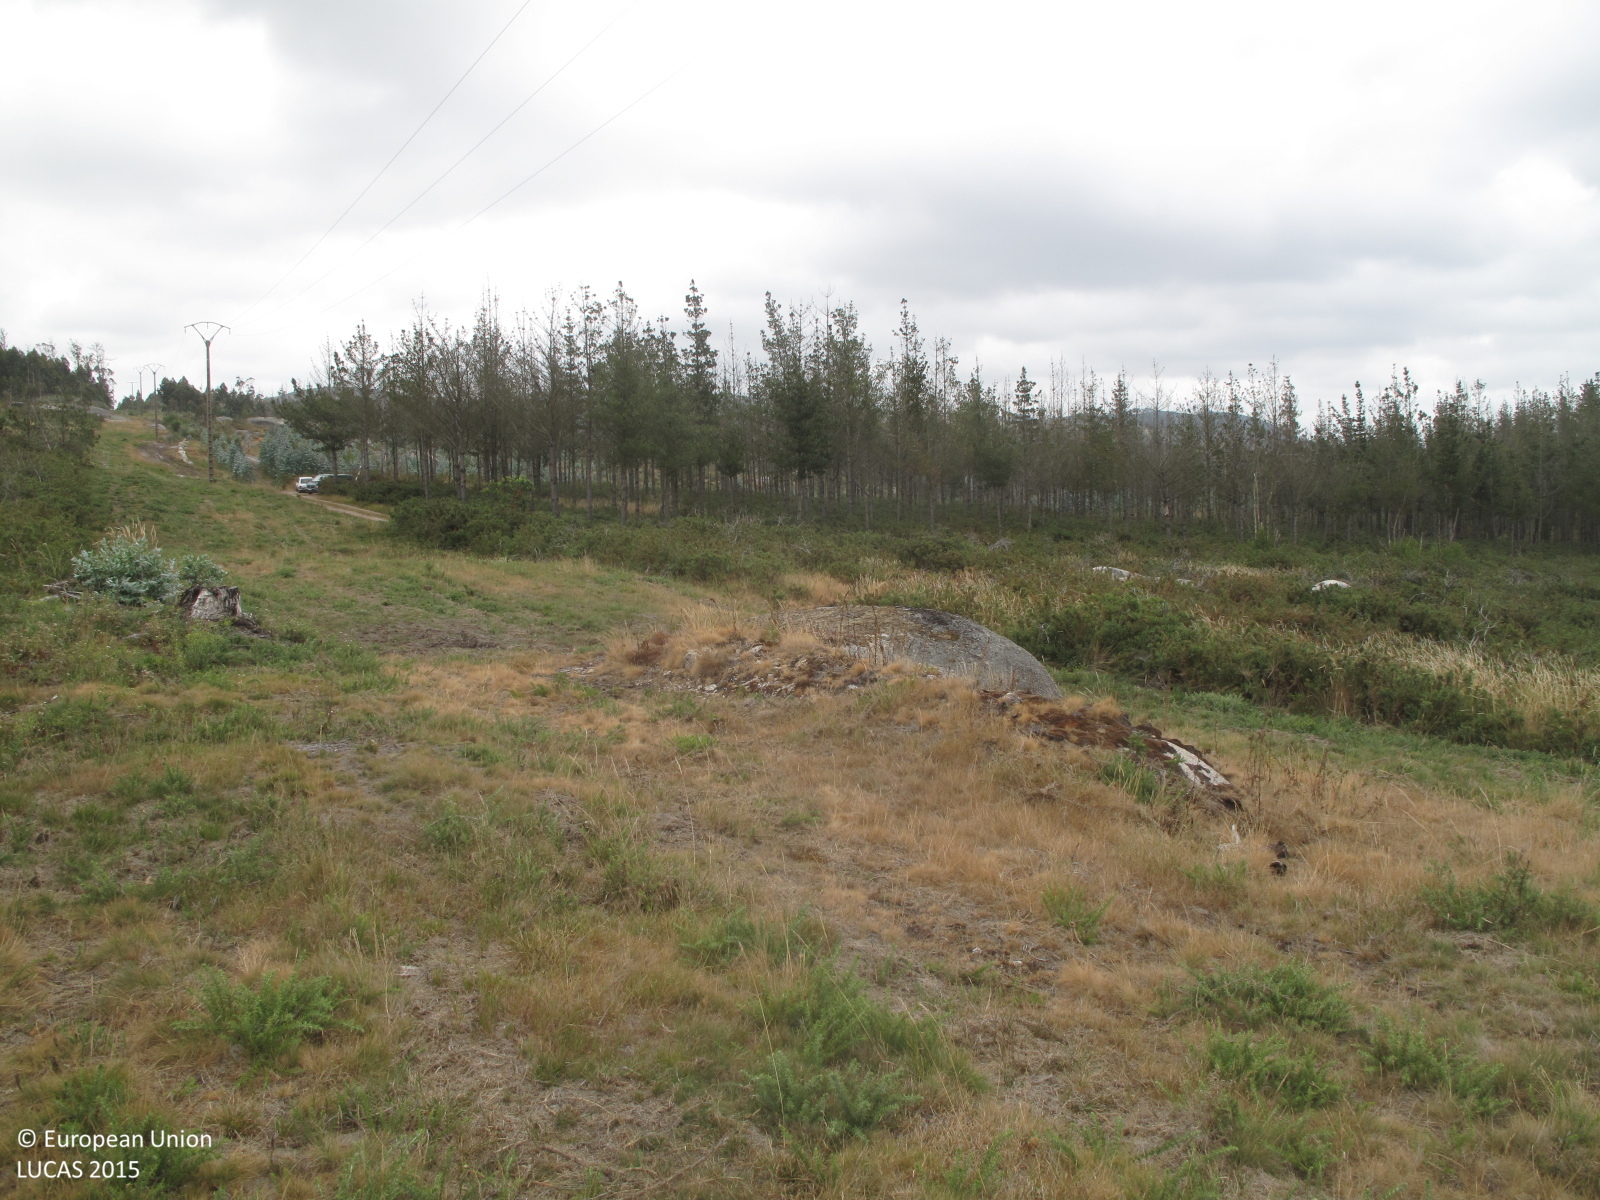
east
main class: Shrubland
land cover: Shrubland with sparse tree cover
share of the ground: > 75 %
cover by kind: shrubs 90 %, broadleaved forest trees 5 %, herbaceous plants 5 %
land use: Abandoned areas
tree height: < 5 m
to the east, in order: Shrubland with sparse tree cover; Grassland with sparse tree/shrub cover; Electric lines; Grassland with sparse tree/shrub cover; Shrubland with sparse tree cover; Tracks; Pine dominated coniferous woodland; Broadleaved woodland
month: July
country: ES
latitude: 43.4171
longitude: -8.0417
